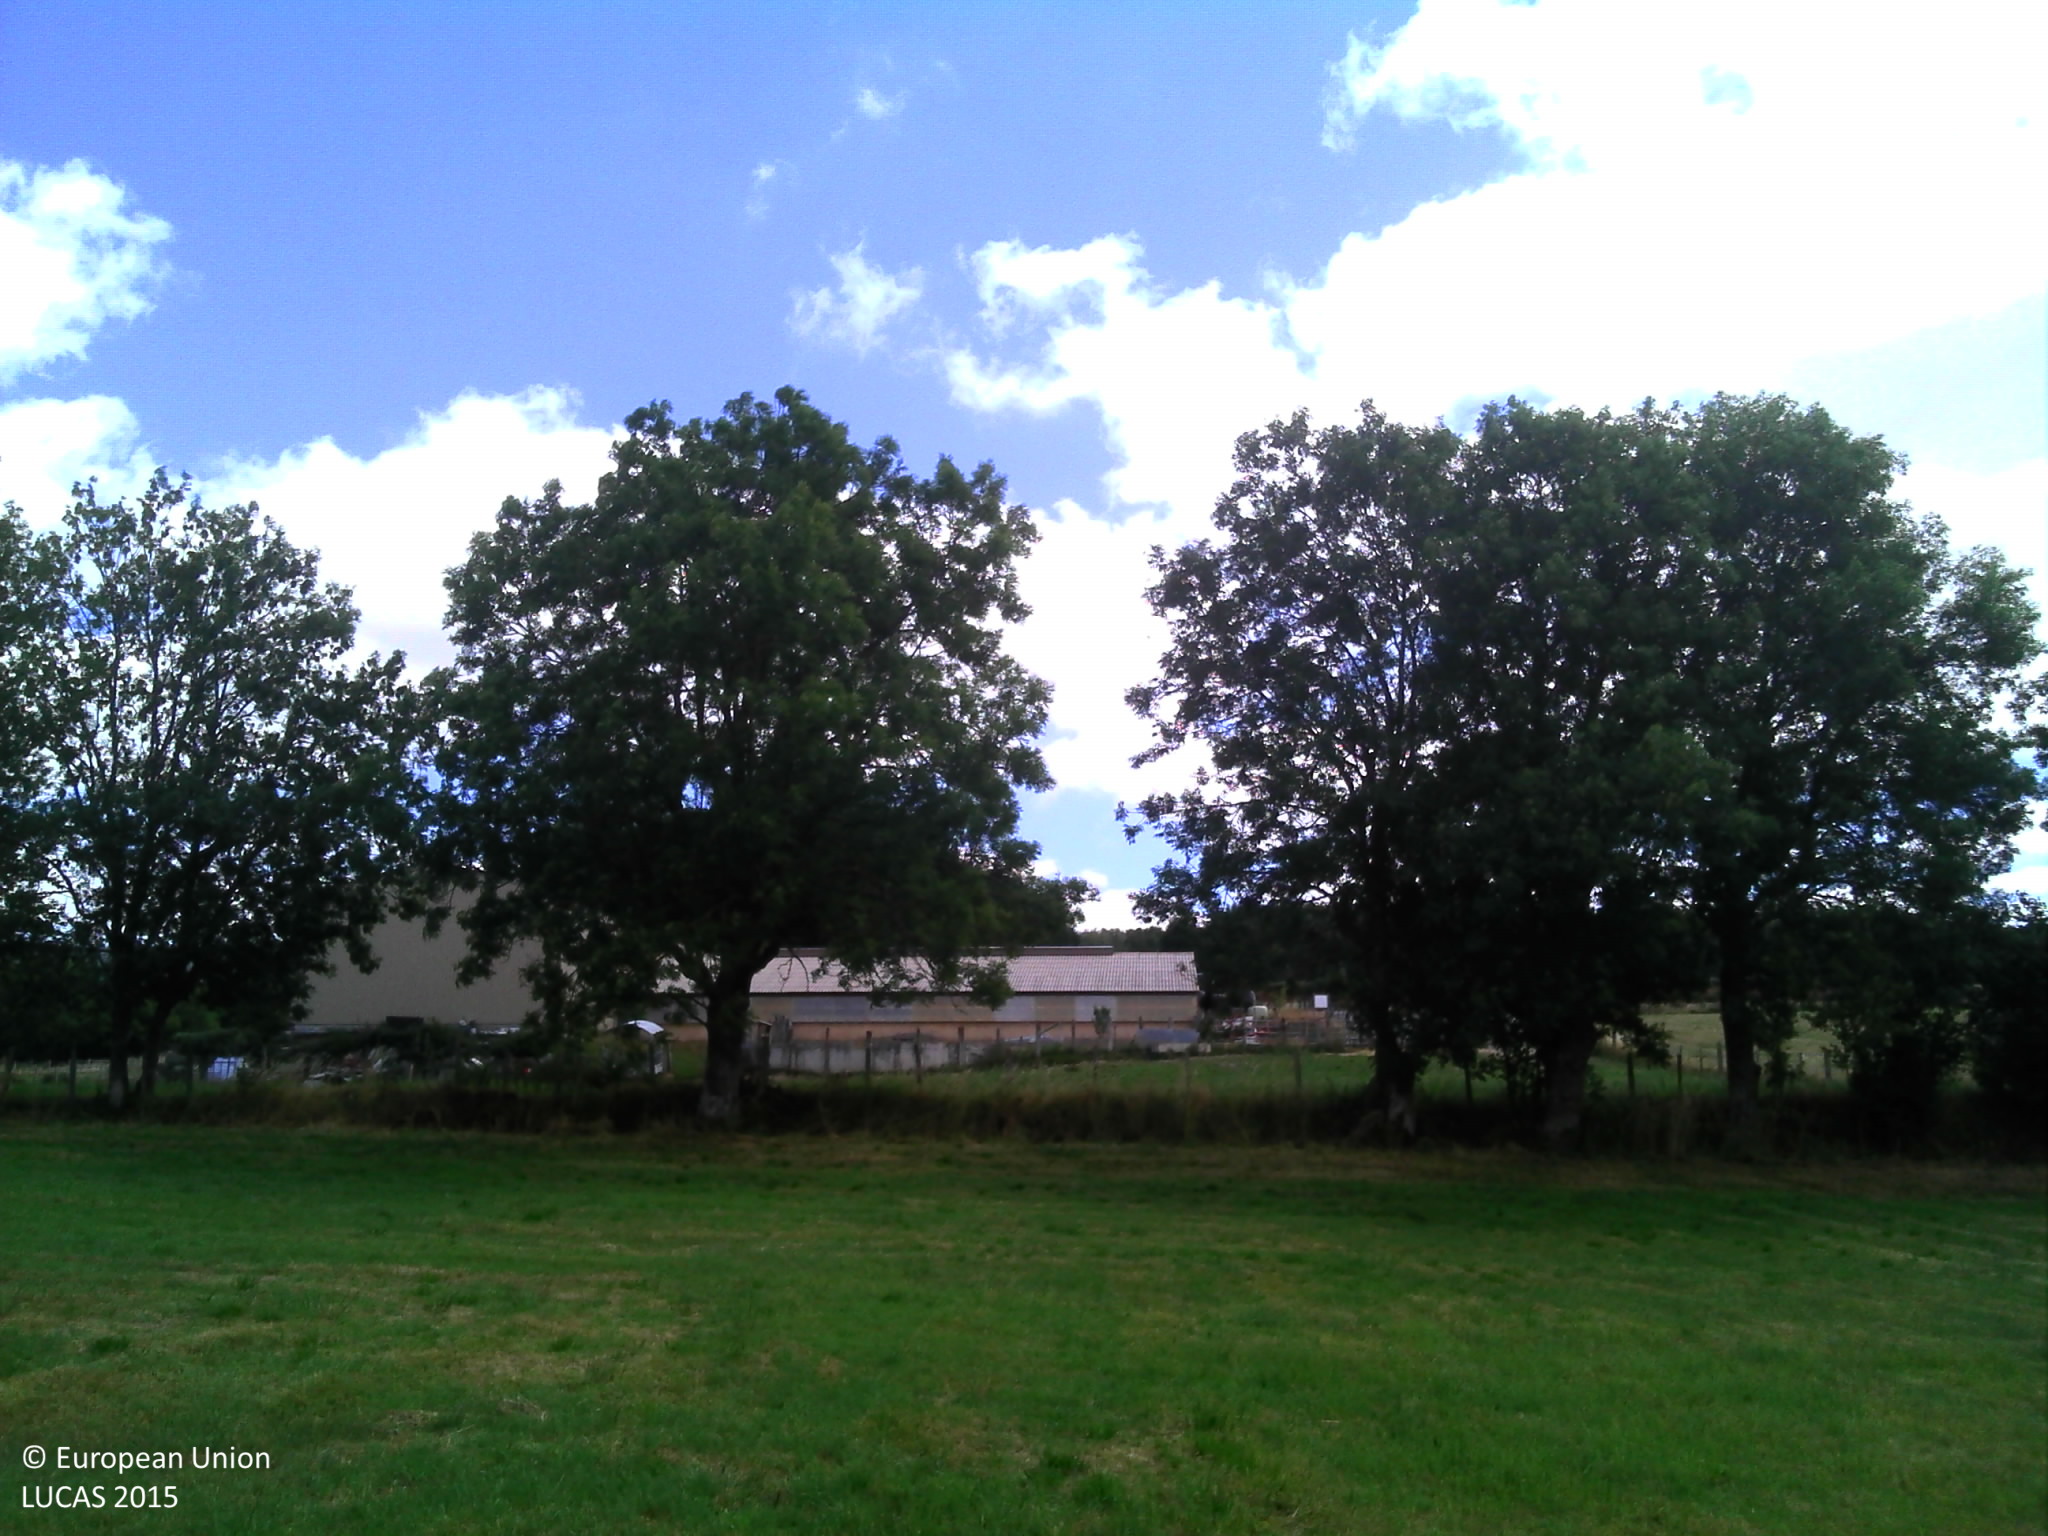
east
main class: Grassland
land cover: Grassland without tree/shrub cover
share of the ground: > 75 %
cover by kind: herbaceous plants 100 %
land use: Agriculture (excluding fallow land and kitchen gardens)
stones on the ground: 10 - 25 %
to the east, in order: Grassland without tree/shrub cover; Fences; Grassland without tree/shrub cover; Lines of trees; Fences; Mixed cereals for fodder; Other bare soil; Artificial constructions in urban areas; Ditches and canals; Abandoned hedges; Fences; Temporary grasslands; Fences; Spruce dominated mixed woodland; Fences; Temporary grasslands
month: July
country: FR
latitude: 44.8122
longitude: 3.4414
